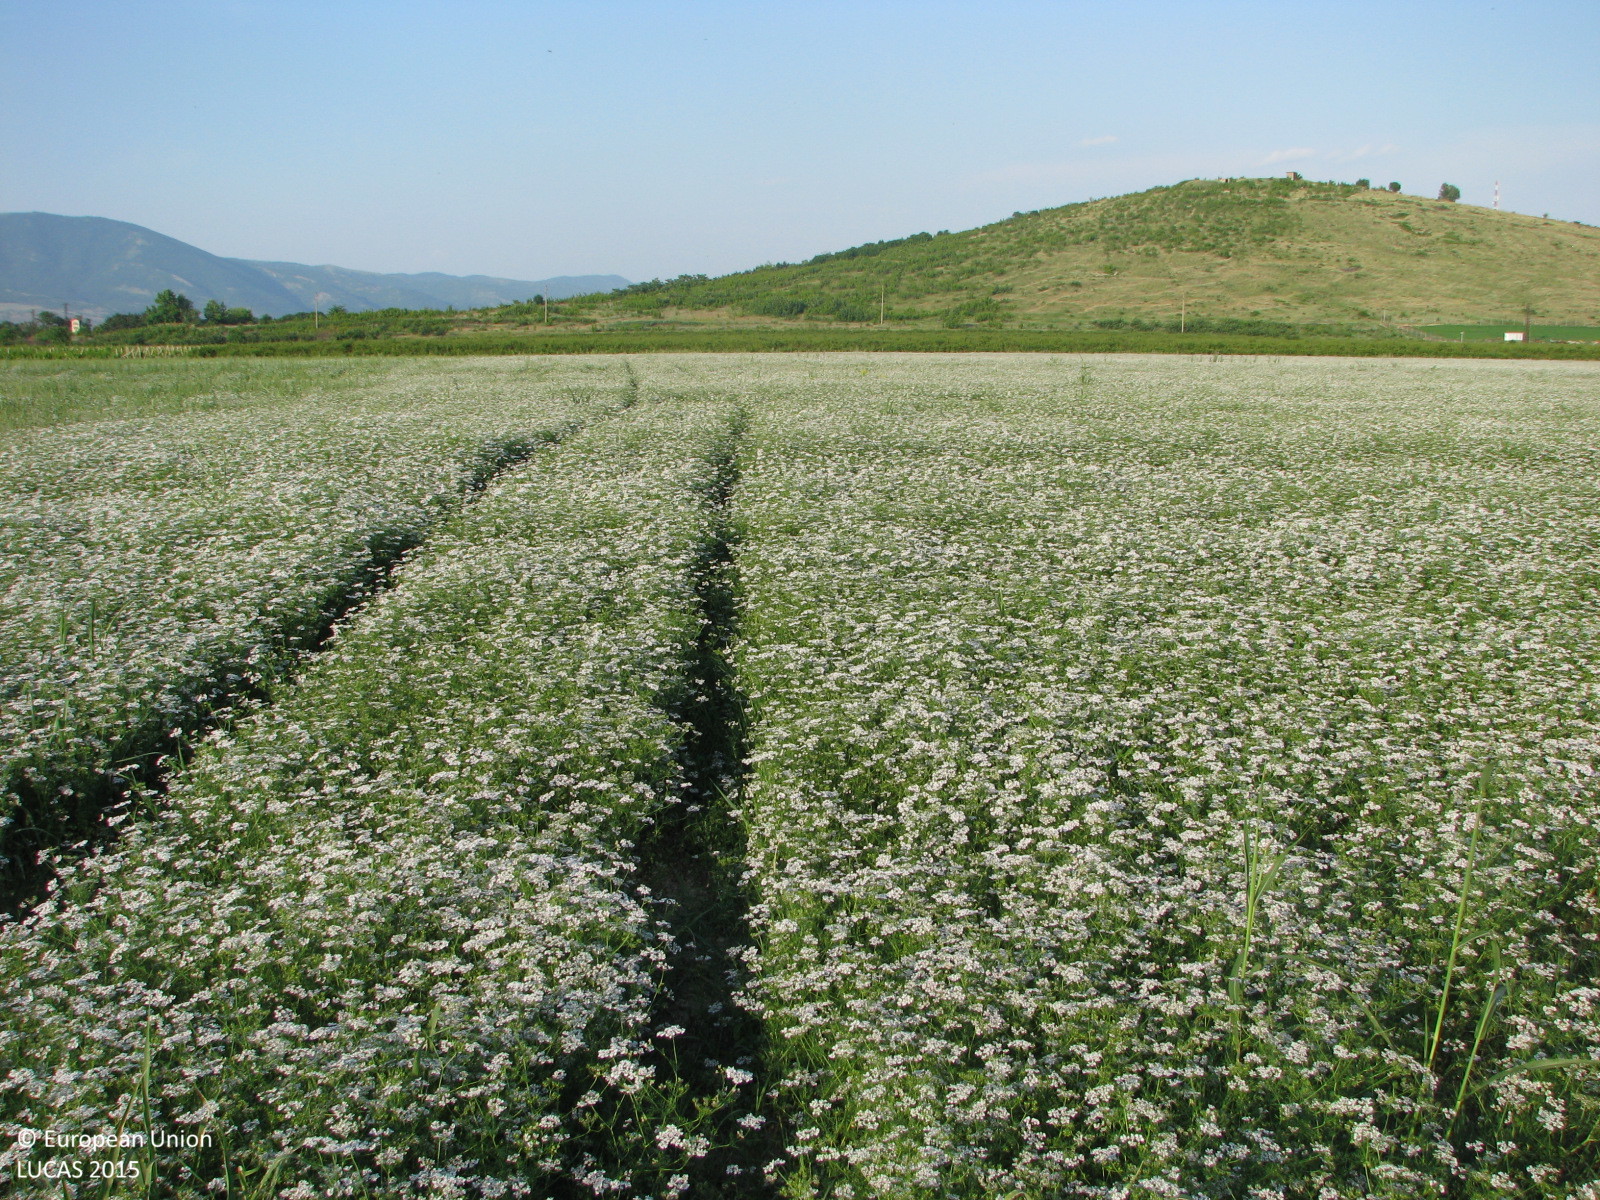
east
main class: Cropland
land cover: Other non-permanent industrial crops
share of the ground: > 75 %
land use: Agriculture (excluding fallow land and kitchen gardens)
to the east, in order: Other non-permanent industrial crops; Grassland without tree/shrub cover; Other fruit trees and berries
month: June
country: BG
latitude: 42.6392
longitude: 26.3472
